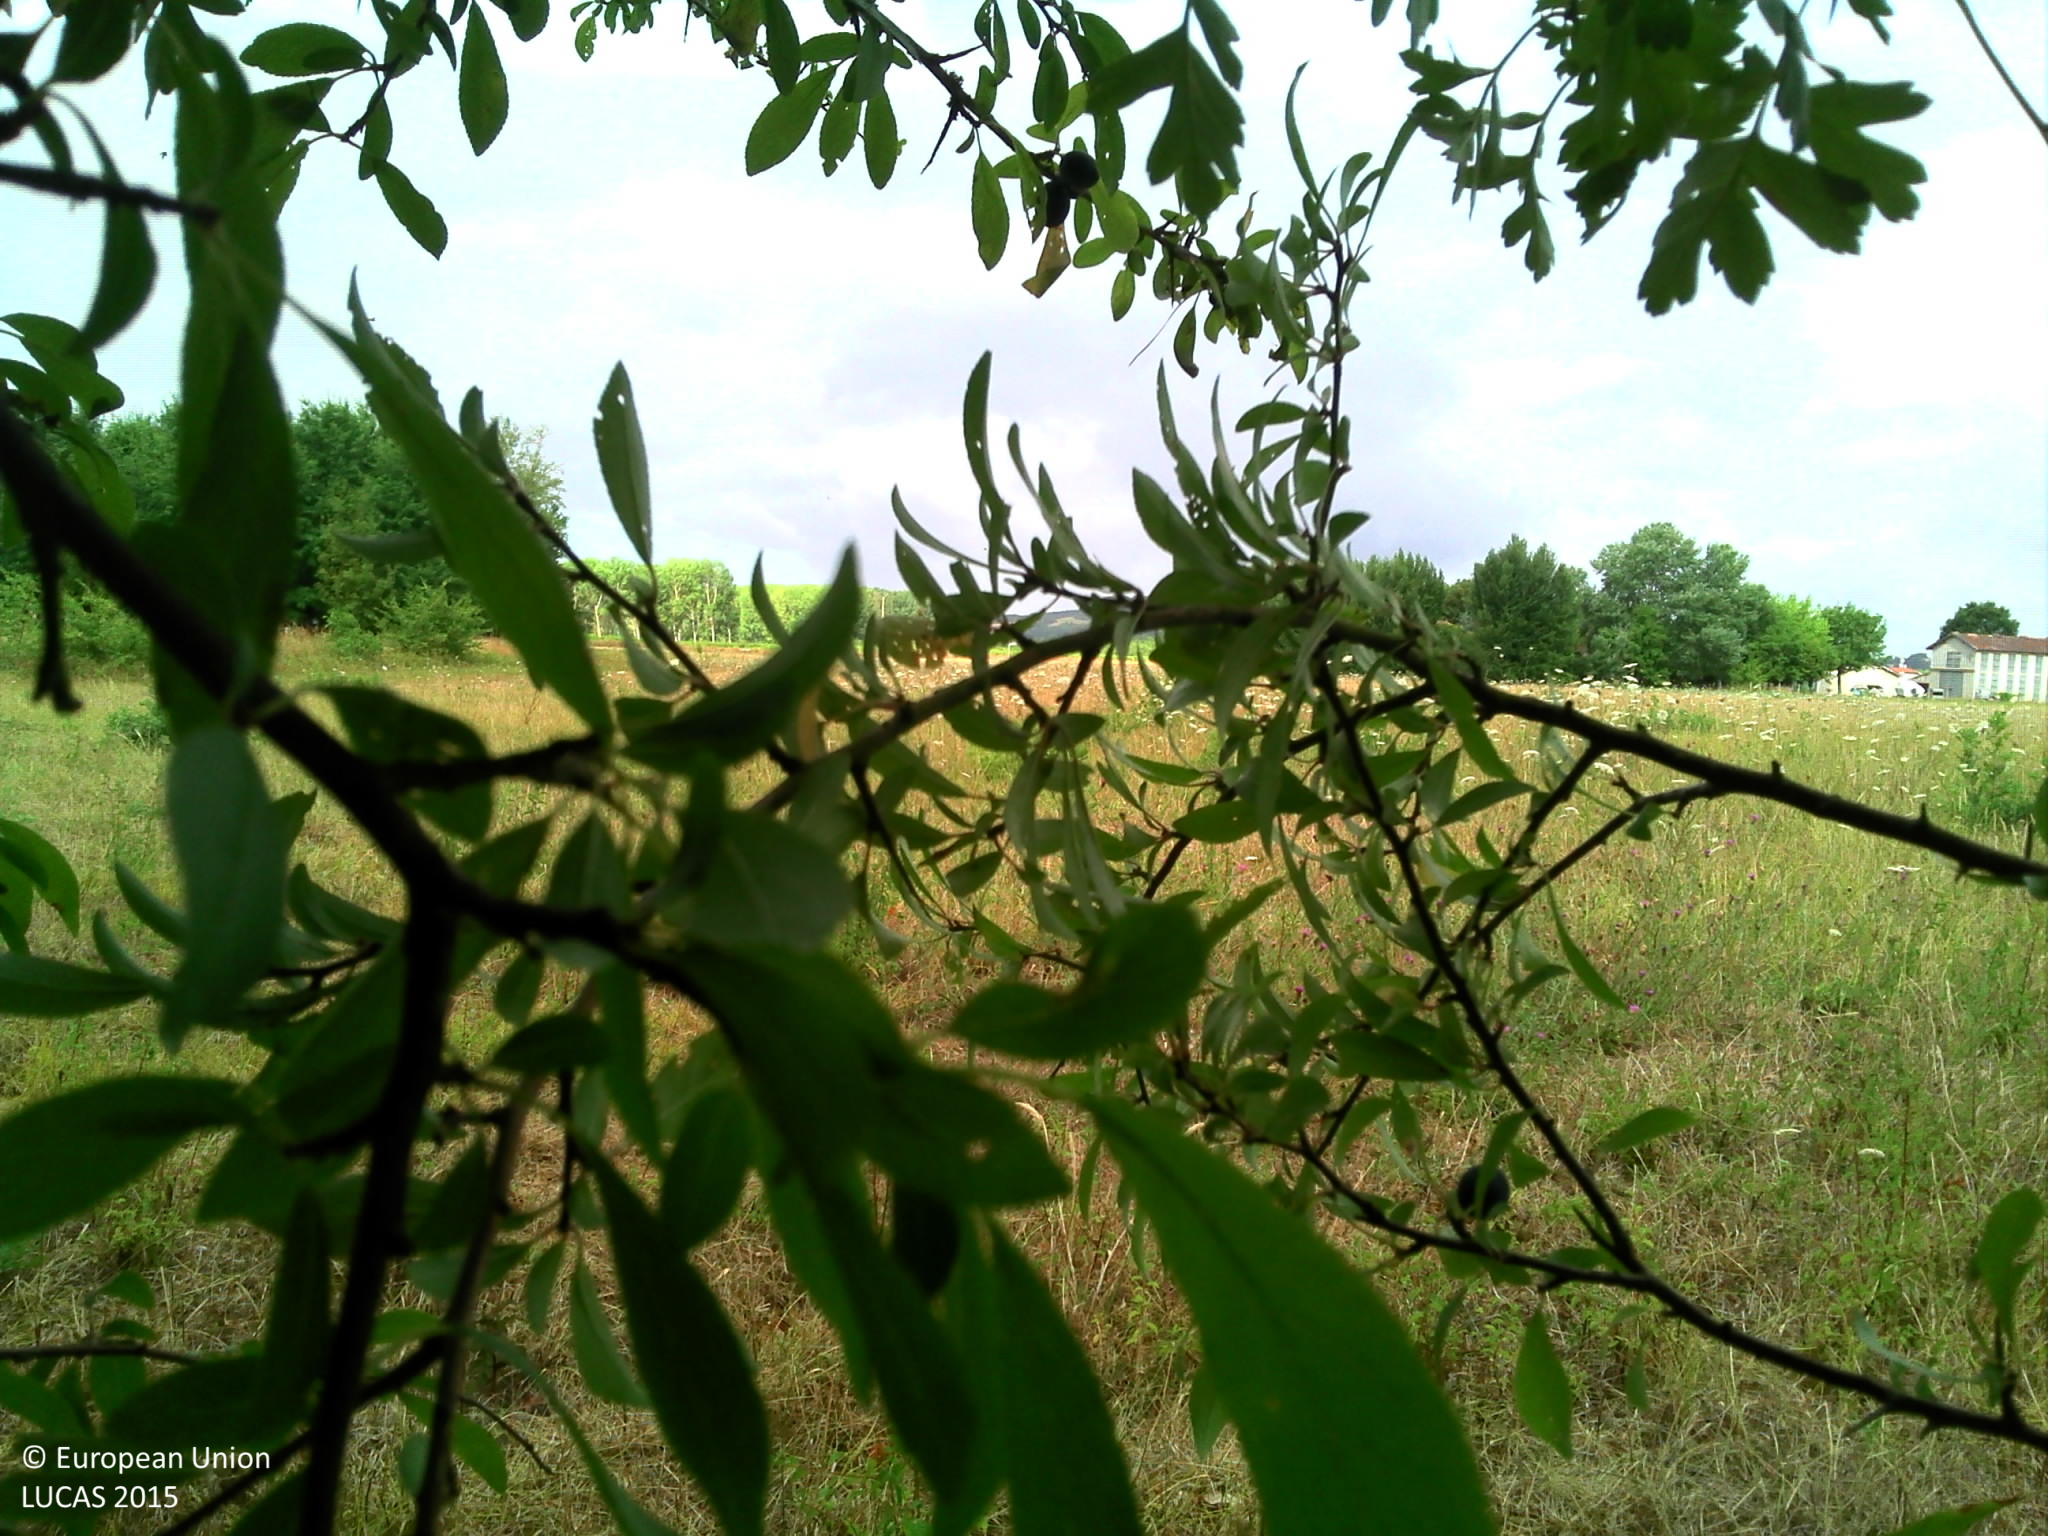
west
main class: Woodland
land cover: Broadleaved woodland
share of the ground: > 75 %
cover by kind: broadleaved forest trees 95 %, shrubs 5 %
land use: Semi-natural and natural areas not in use
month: July
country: FR
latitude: 44.4096
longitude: 0.5624
